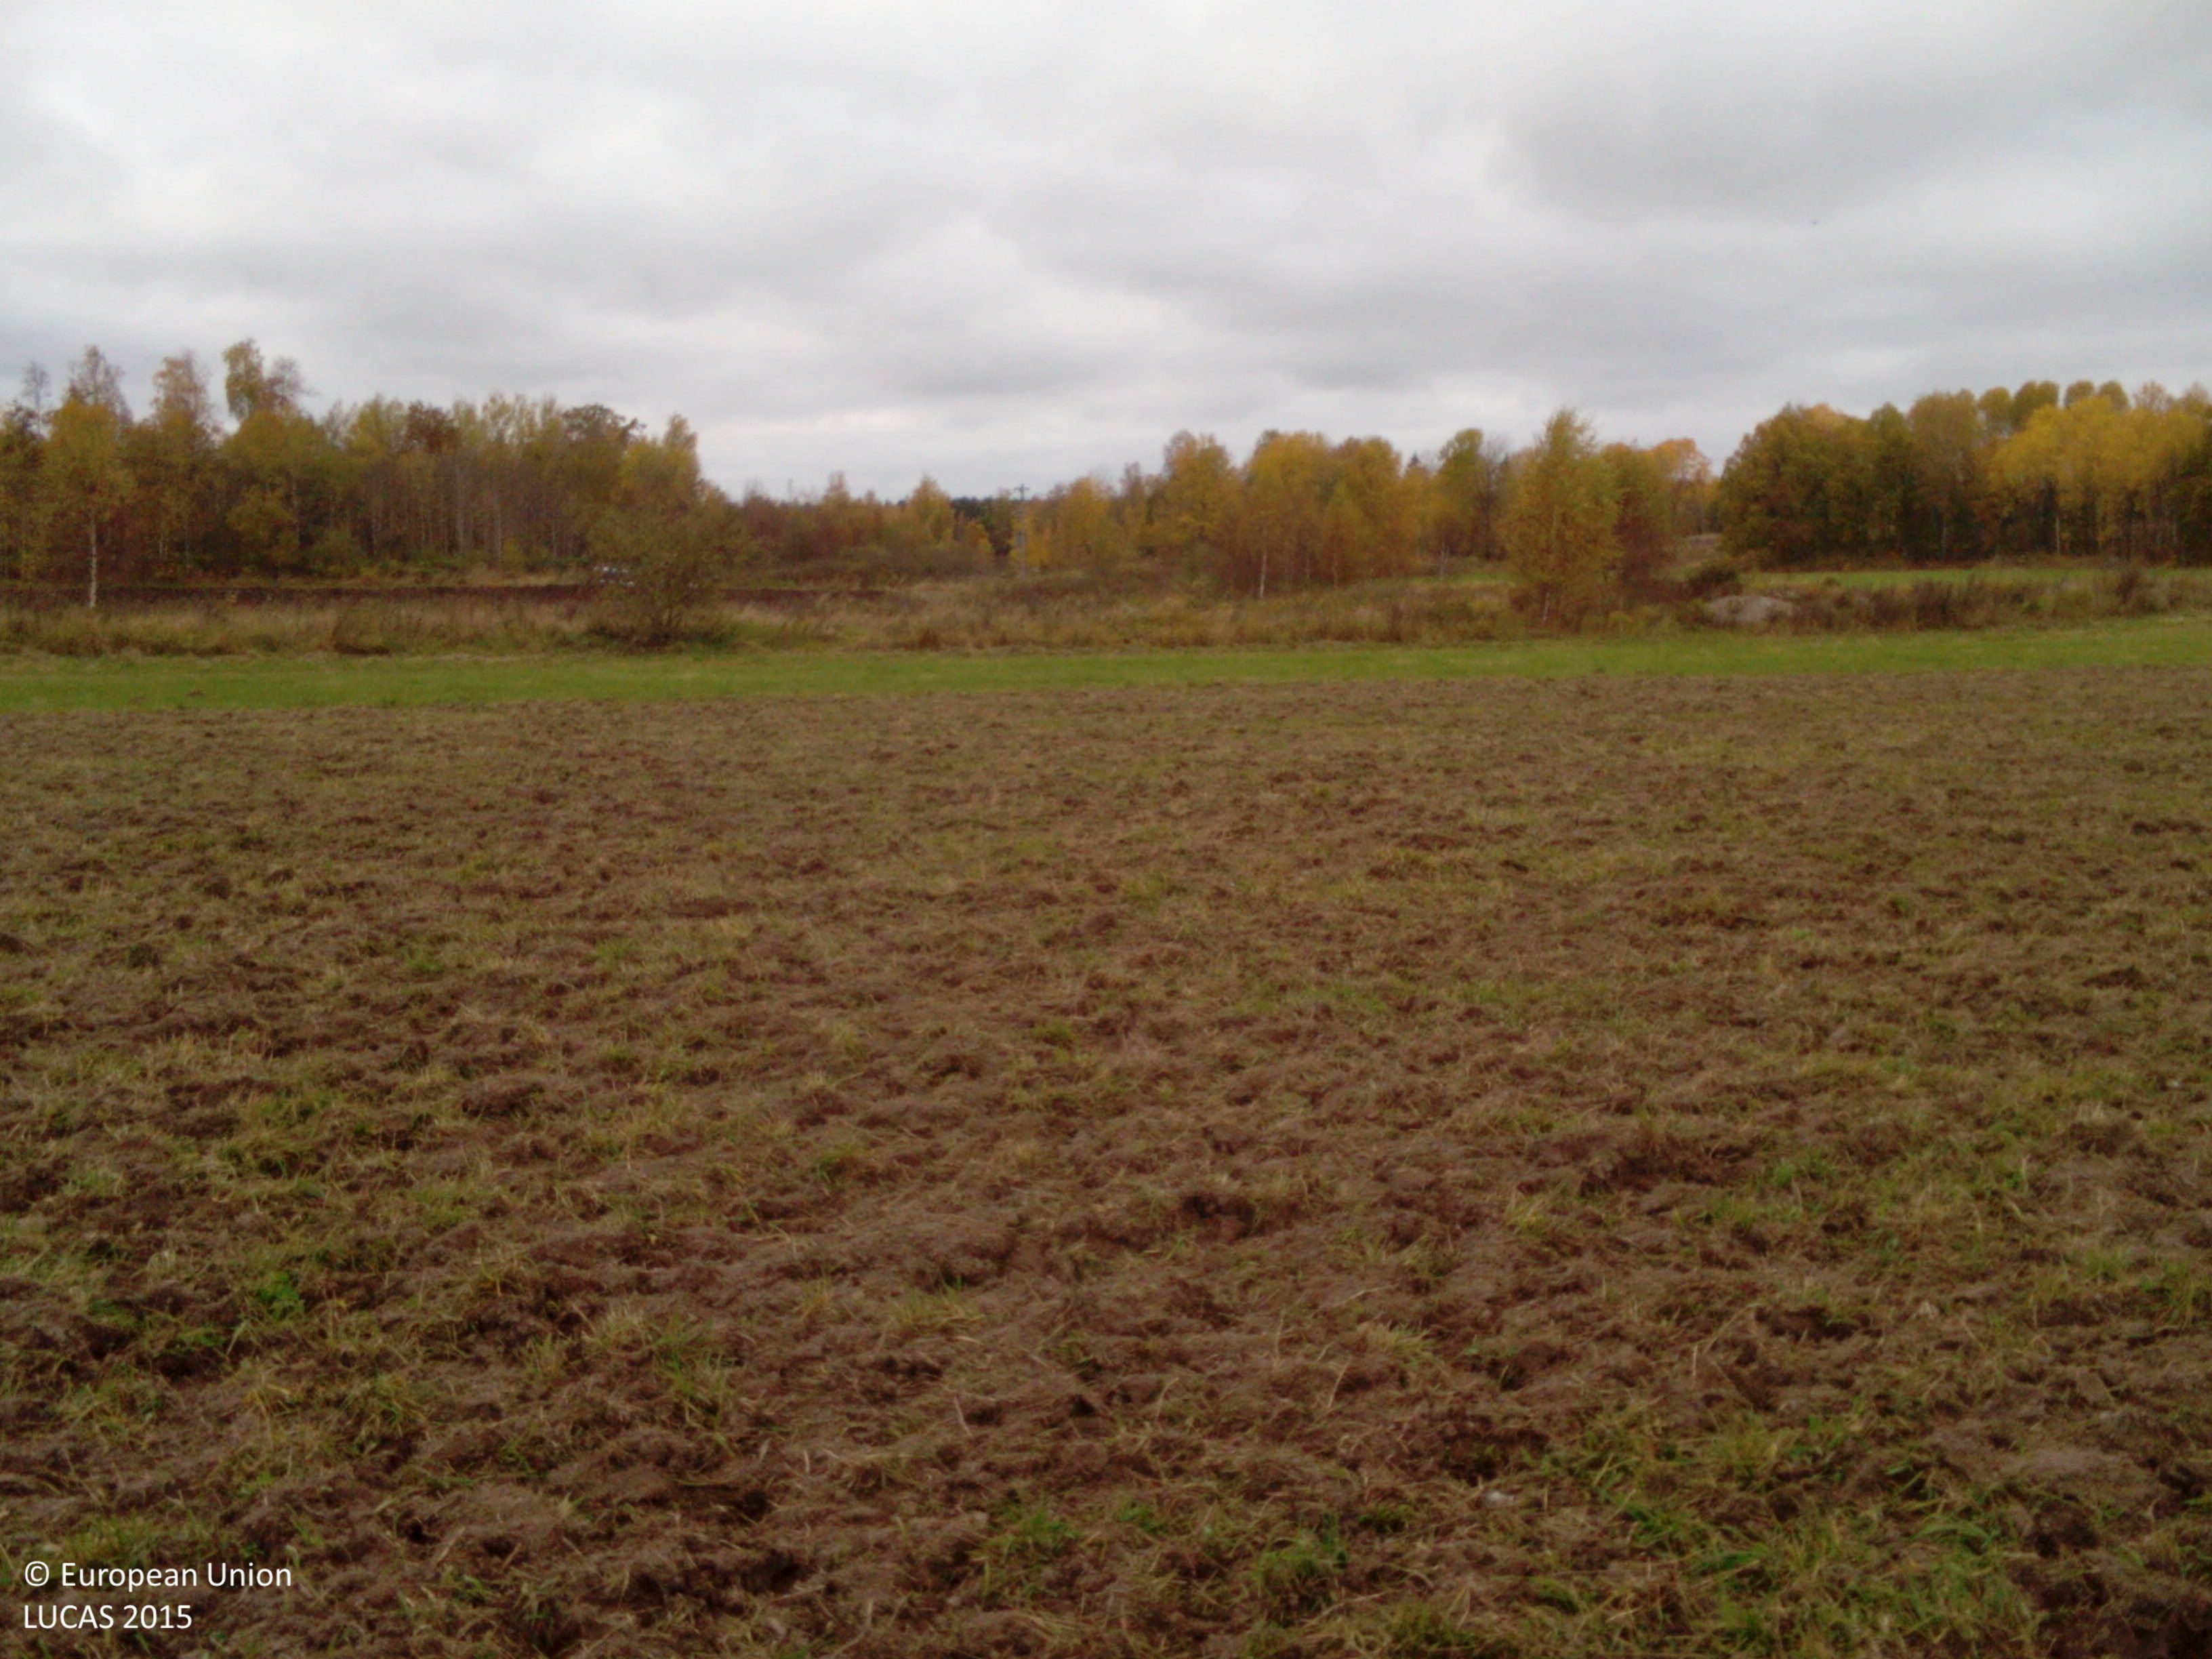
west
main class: Grassland
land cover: Grassland without tree/shrub cover
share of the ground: < 10 %
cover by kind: unconsolidated bare surface 80 %, herbaceous plants 10 %, consolidated bare surface 10 %
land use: Agriculture (excluding fallow land and kitchen gardens)
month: October
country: SE
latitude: 59.2311
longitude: 16.2143
